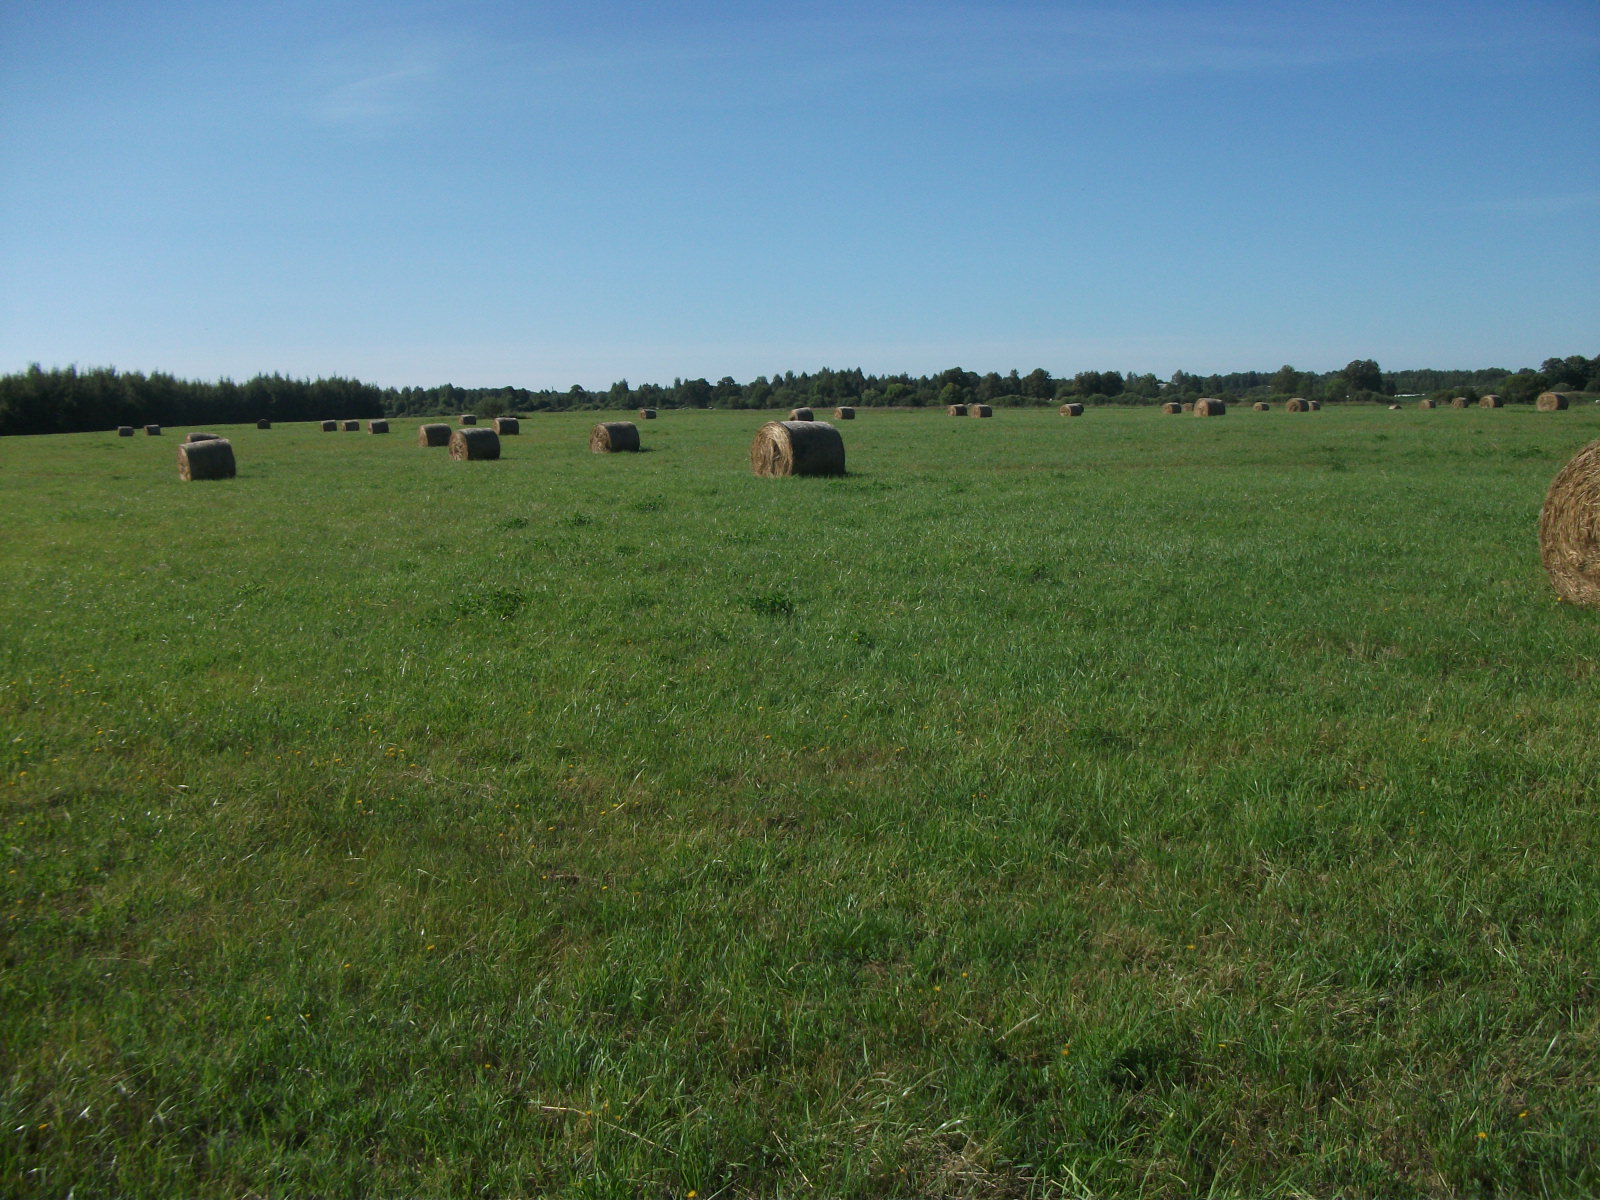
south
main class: Grassland
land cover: Grassland without tree/shrub cover
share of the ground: > 75 %
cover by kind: herbaceous plants 100 %
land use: Agriculture (excluding fallow land and kitchen gardens)
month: August
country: LV
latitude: 56.3304
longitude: 26.2998
